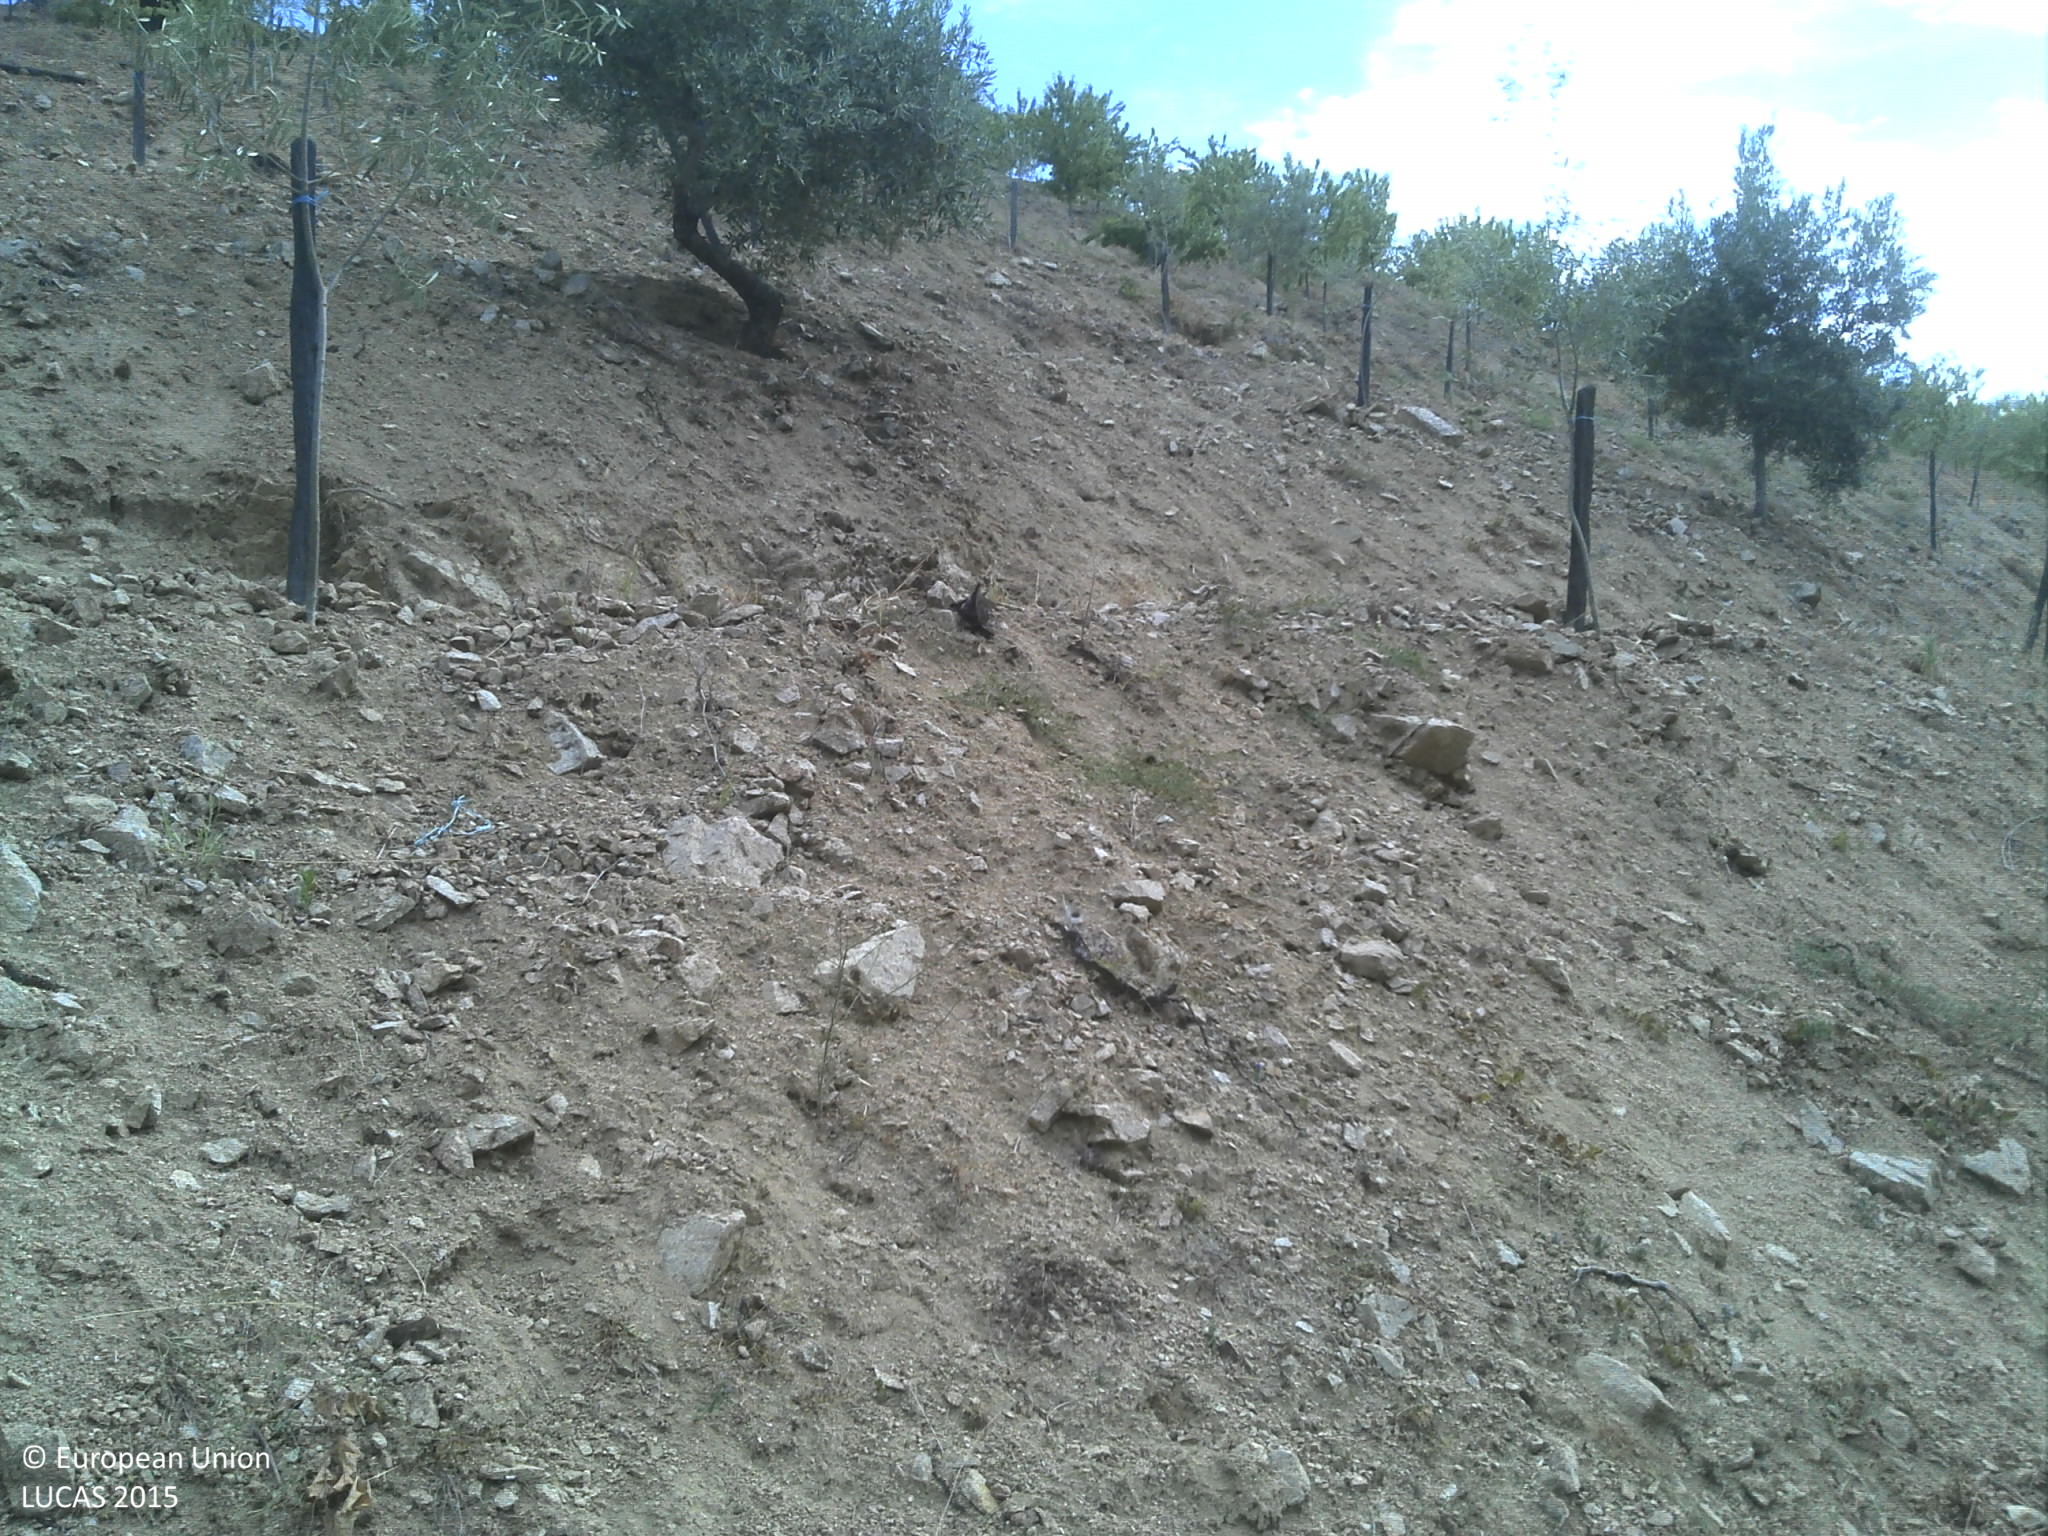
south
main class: Cropland
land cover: Olive groves
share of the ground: 10 - 25 %
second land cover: Other bare soil
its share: > 75 %
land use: Agriculture (excluding fallow land and kitchen gardens)
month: July
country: PT
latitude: 41.0705
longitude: -7.2396
